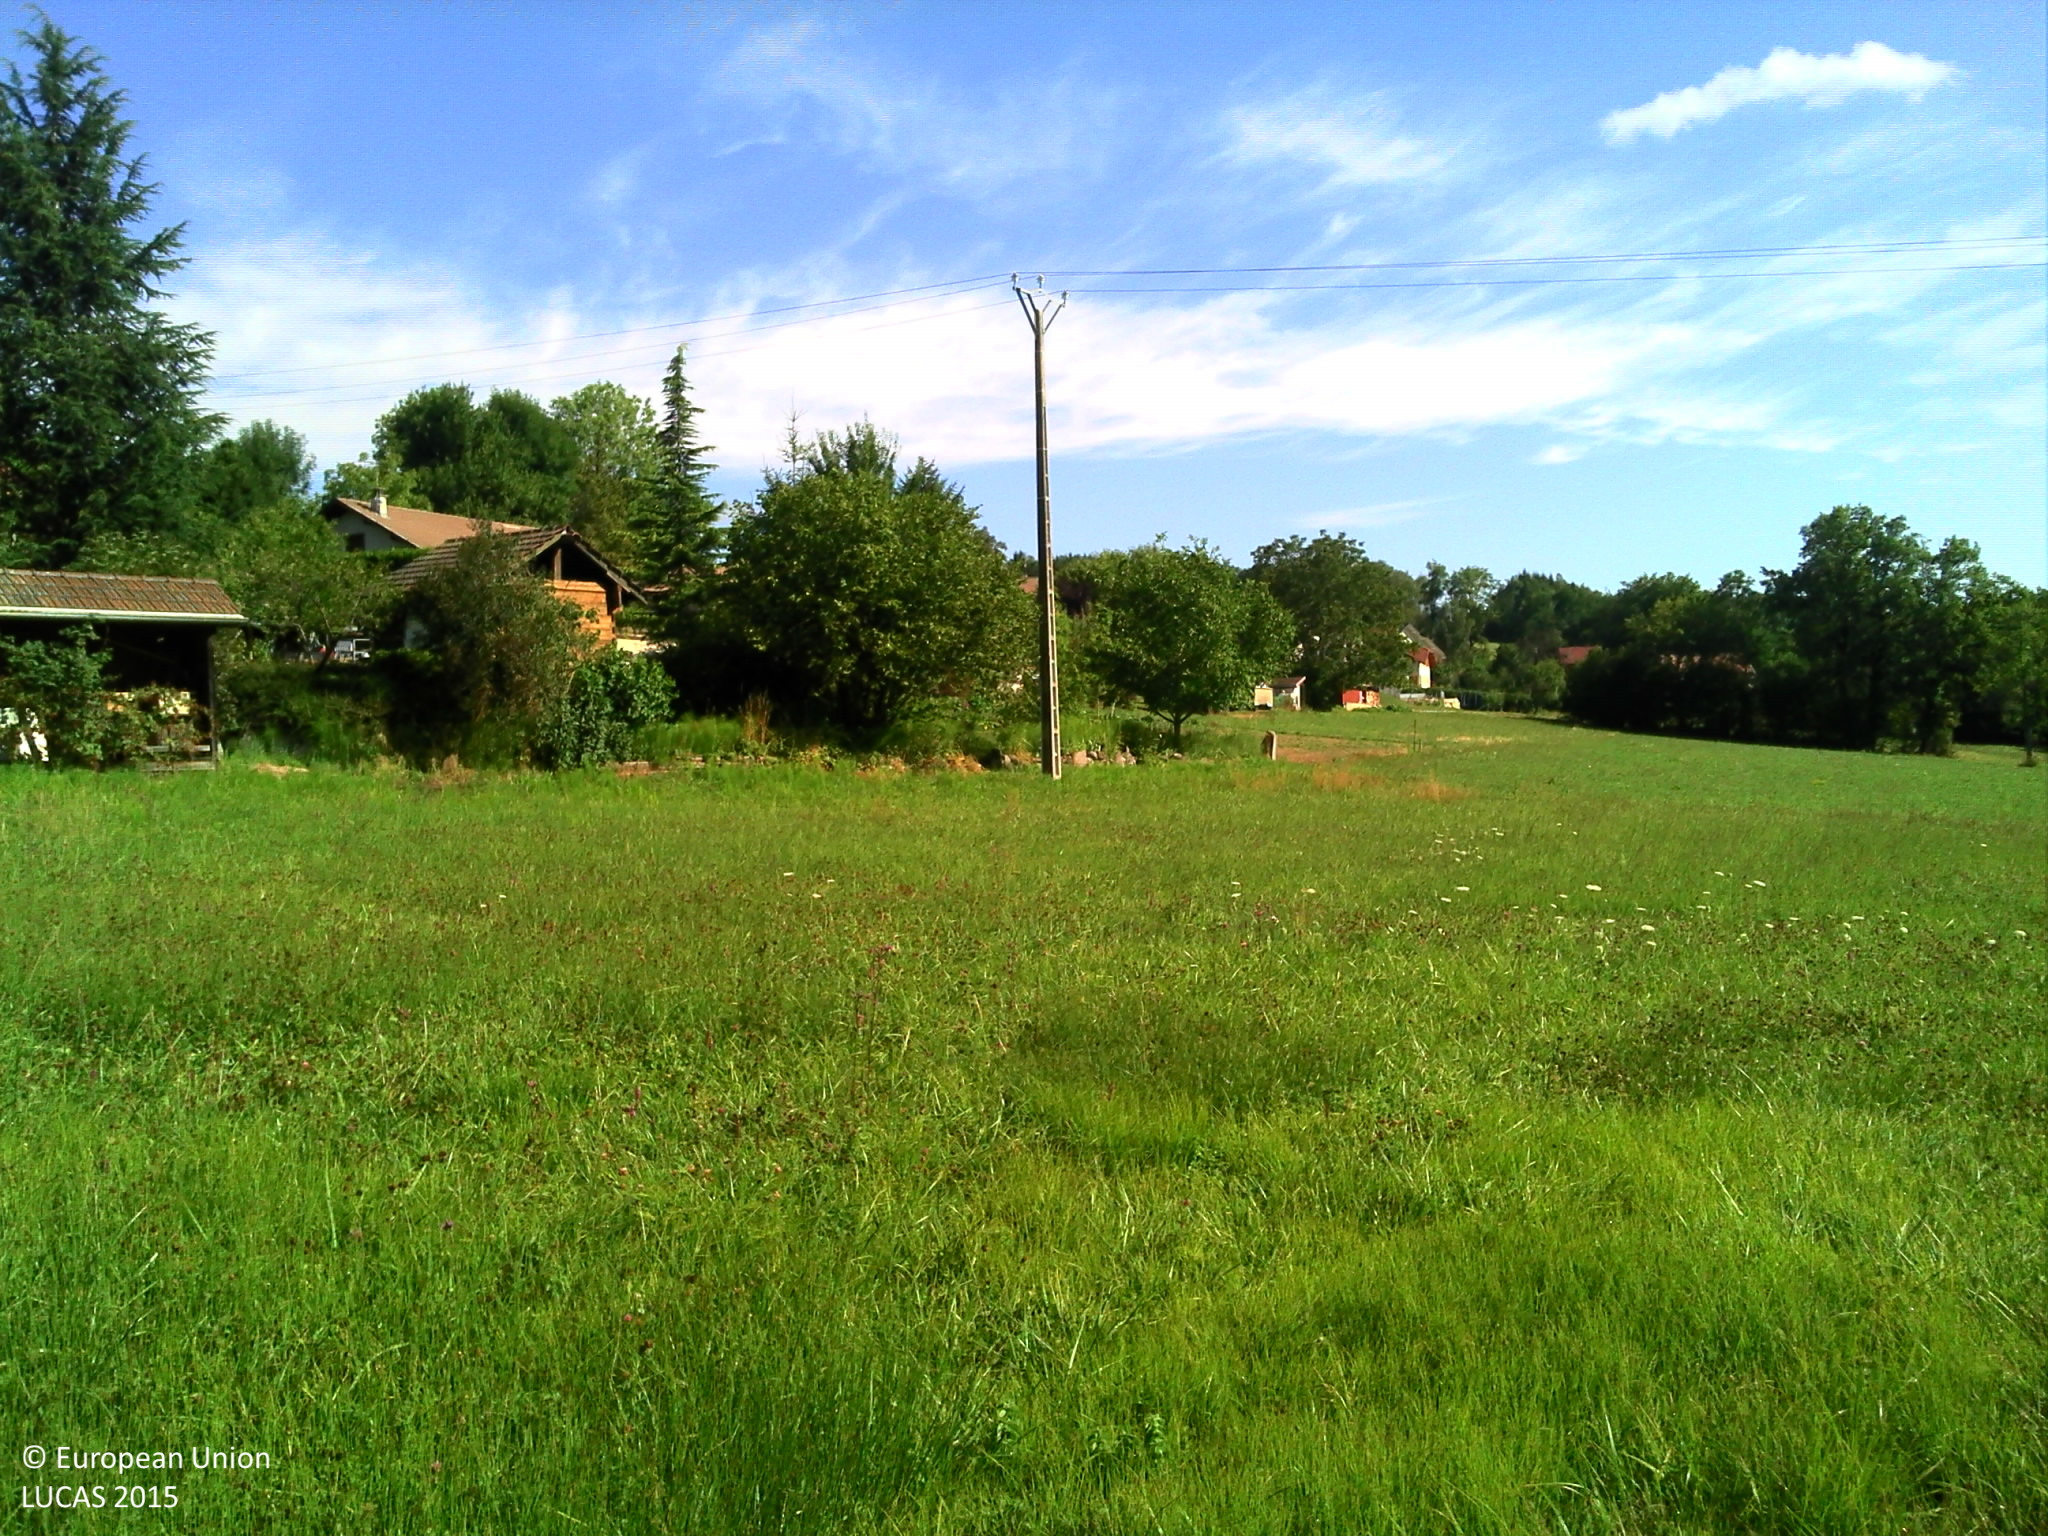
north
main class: Grassland
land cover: Grassland without tree/shrub cover
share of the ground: > 75 %
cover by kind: herbaceous plants 100 %
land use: Agriculture (excluding fallow land and kitchen gardens)
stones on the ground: < 10 %
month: July
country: FR
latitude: 45.9752
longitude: 6.1448
